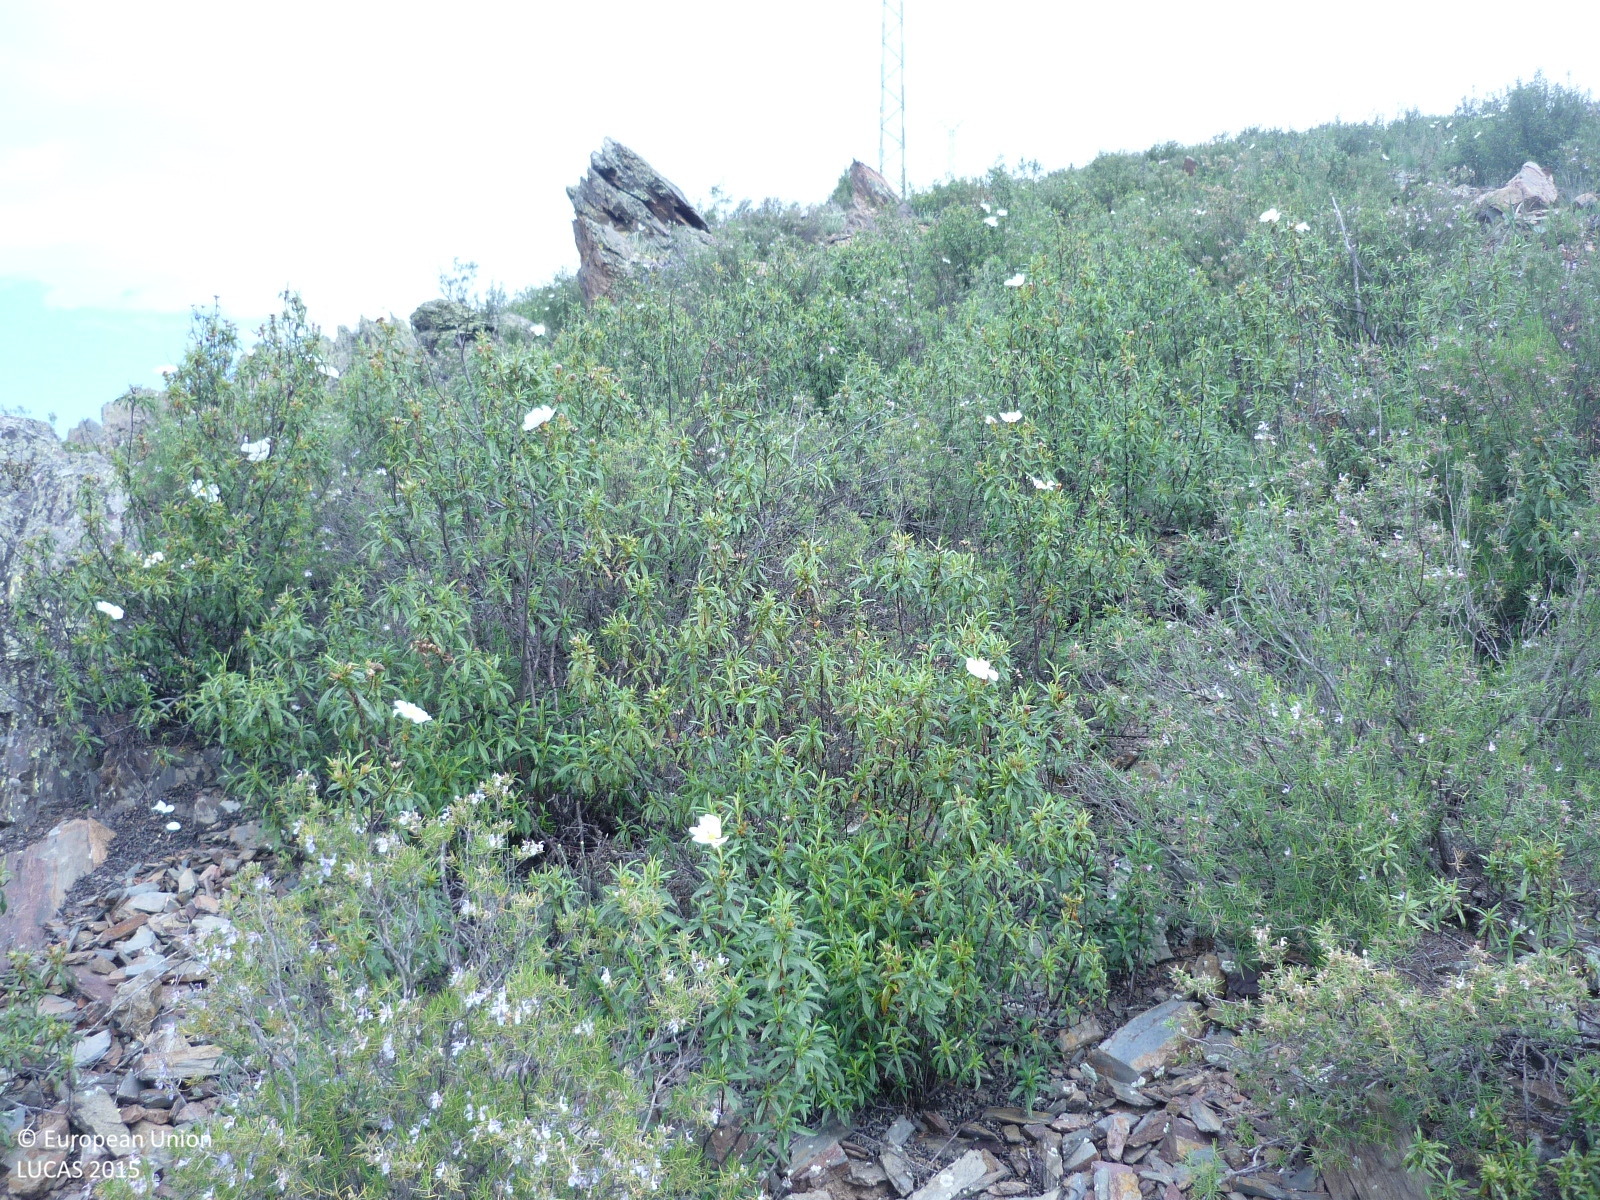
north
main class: Shrubland
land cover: Shrubland without tree cover
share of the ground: > 75 %
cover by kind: shrubs 65 %, unconsolidated bare surface 20 %, herbaceous plants 15 %
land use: Semi-natural and natural areas not in use
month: April
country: ES
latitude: 40.9263
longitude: -3.4718
